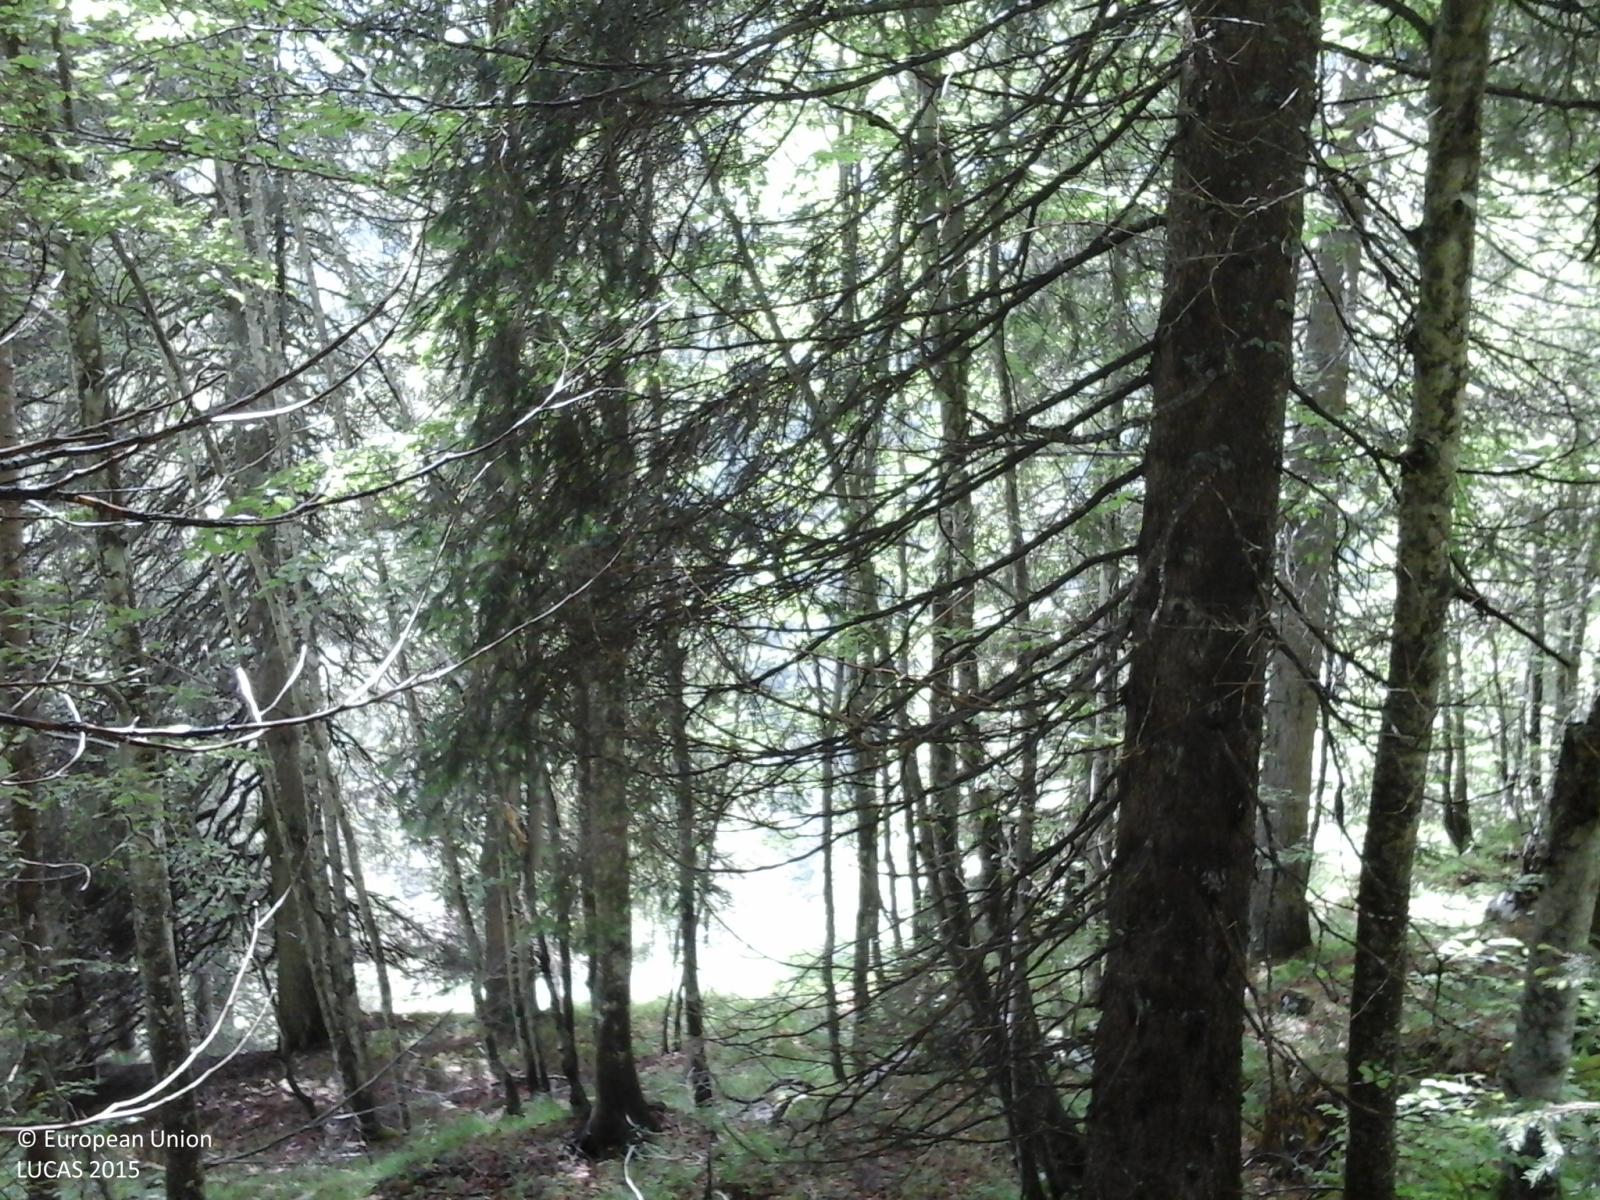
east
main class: Woodland
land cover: Spruce dominated coniferous woodland
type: alpine coniferous forest
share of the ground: > 75 %
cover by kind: coniferous forest trees 100 %
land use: Forestry
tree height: > 5 m
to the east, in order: Spruce dominated coniferous woodland; Tracks; Spruce dominated coniferous woodland
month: June
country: IT
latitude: 45.9438
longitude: 11.5328
